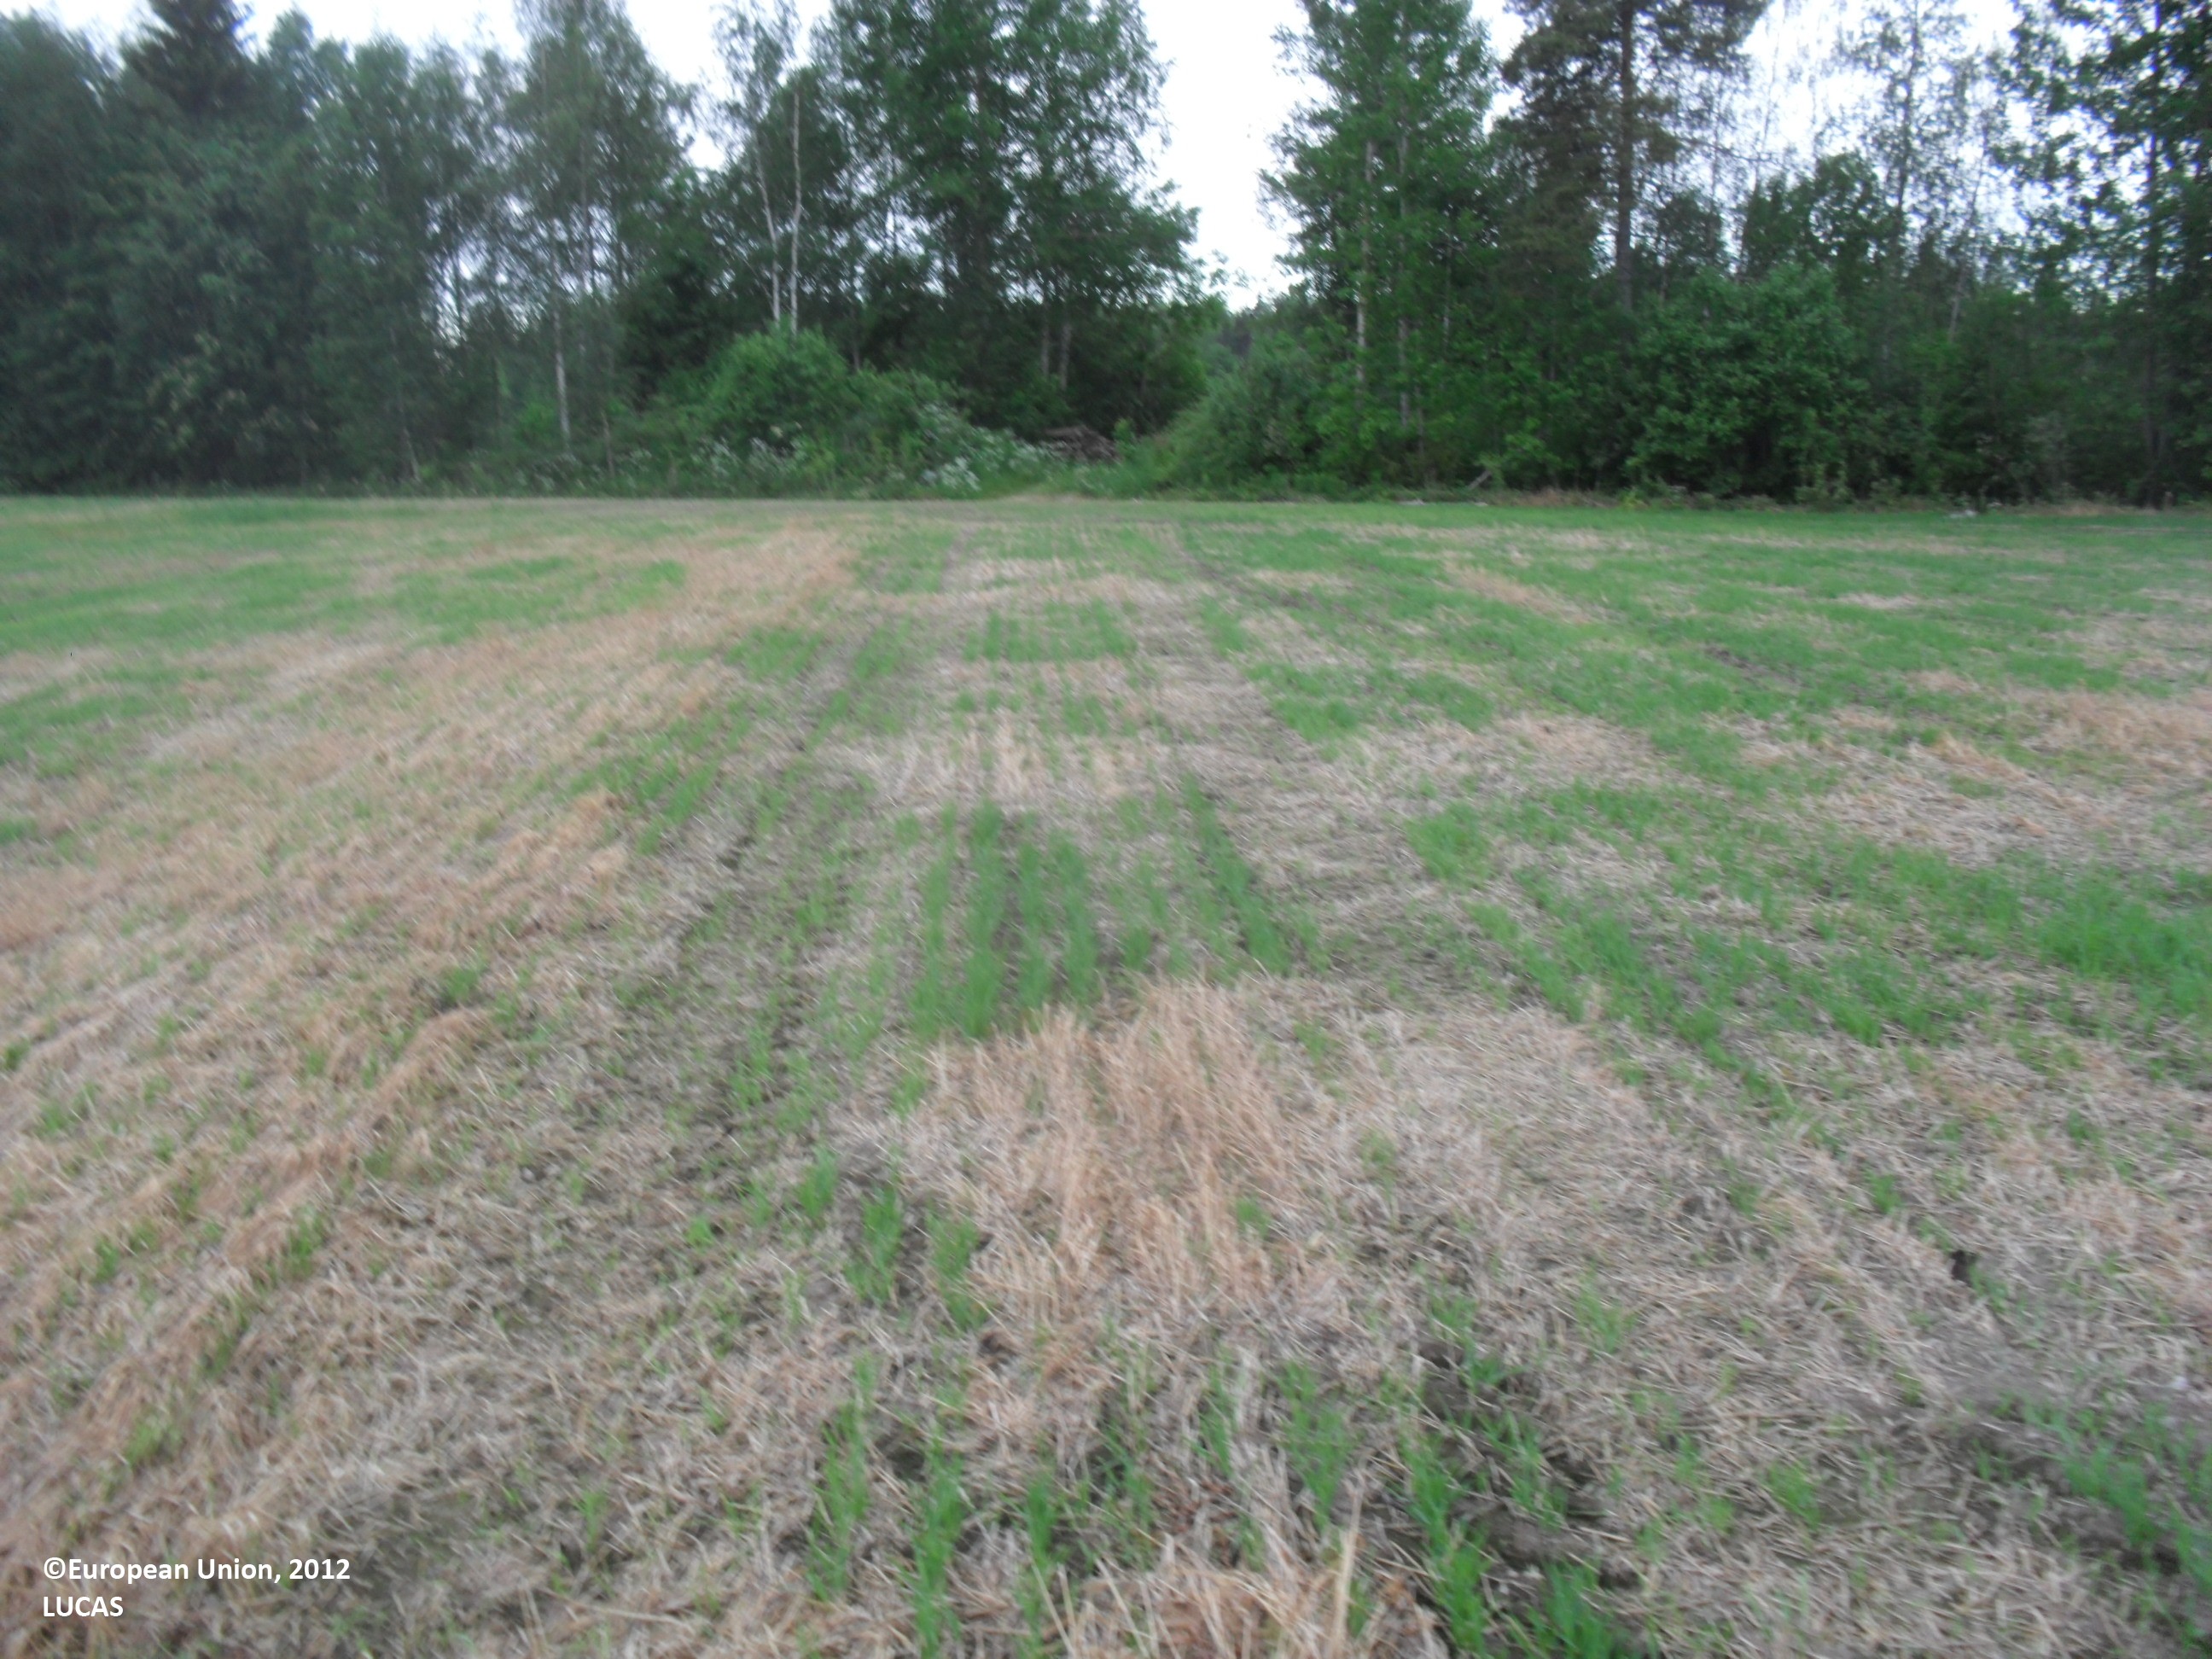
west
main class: Cropland
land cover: Barley
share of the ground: < 10 %
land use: Agriculture (excluding fallow land and kitchen gardens)
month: June
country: FI
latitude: 63.3216
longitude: 23.2962
